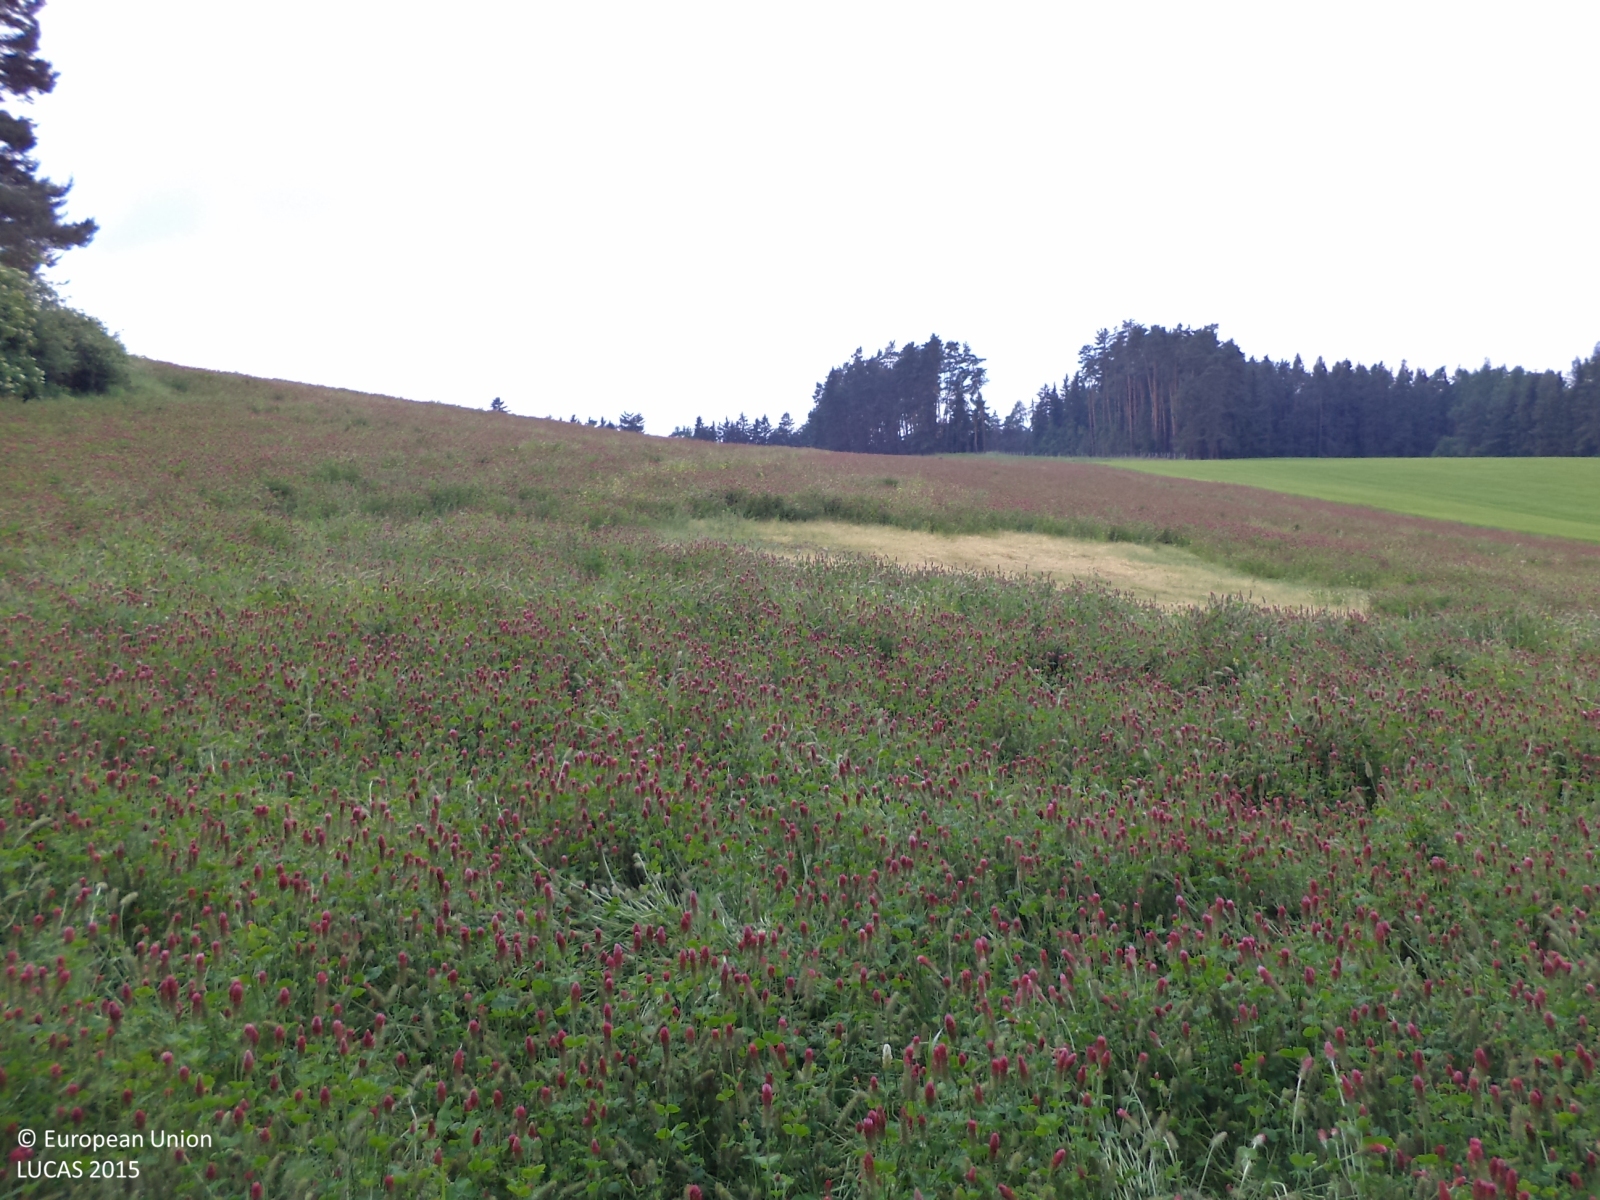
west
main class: Woodland
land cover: Pine dominated mixed woodland
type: hemiboreal forest and nemoral coniferous forest and mixed broadleaved-coniferous forest
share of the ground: > 75 %
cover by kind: coniferous forest trees 60 %, broadleaved forest trees 30 %, shrubs 10 %
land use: Forestry
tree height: > 5 m
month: June
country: CZ
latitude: 49.1975
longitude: 14.4338
